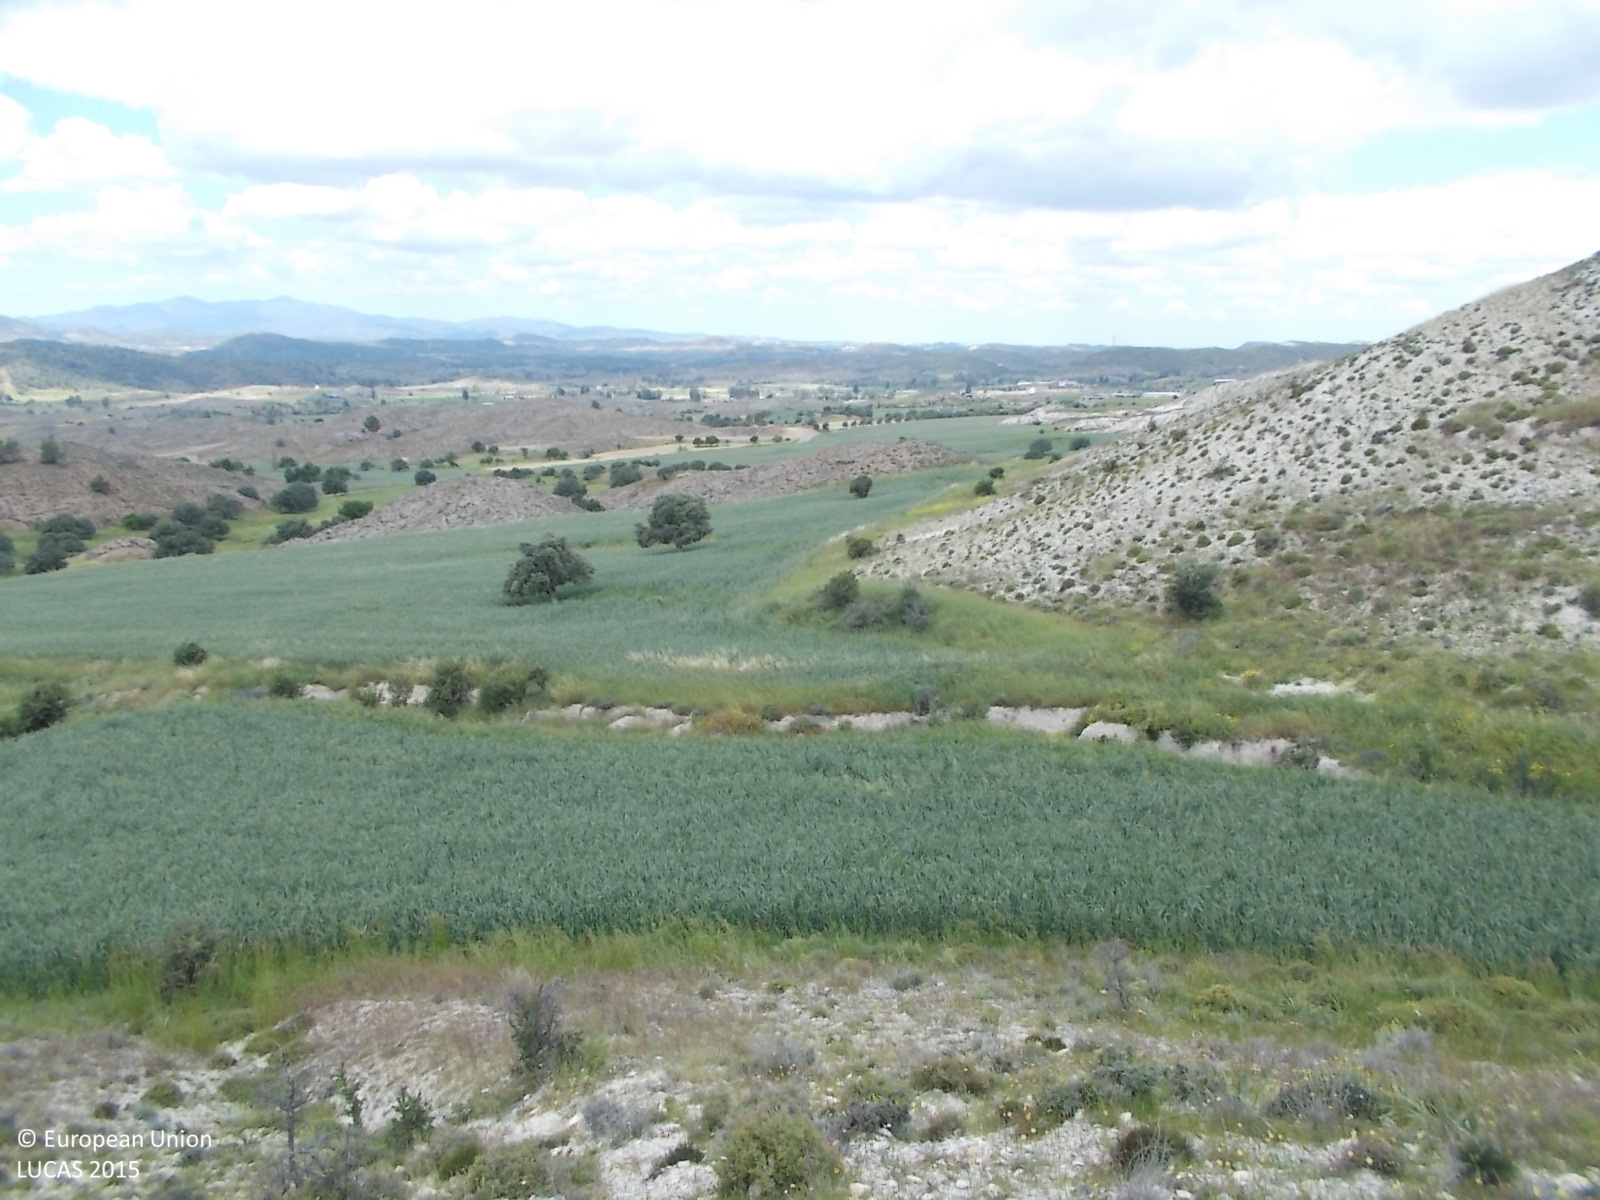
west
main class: Shrubland
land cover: Shrubland without tree cover
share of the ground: 25 - 50 %
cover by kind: unconsolidated bare surface 60 %, shrubs 40 %
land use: Semi-natural and natural areas not in use
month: April
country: CY
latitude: 34.9735
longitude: 33.4673
